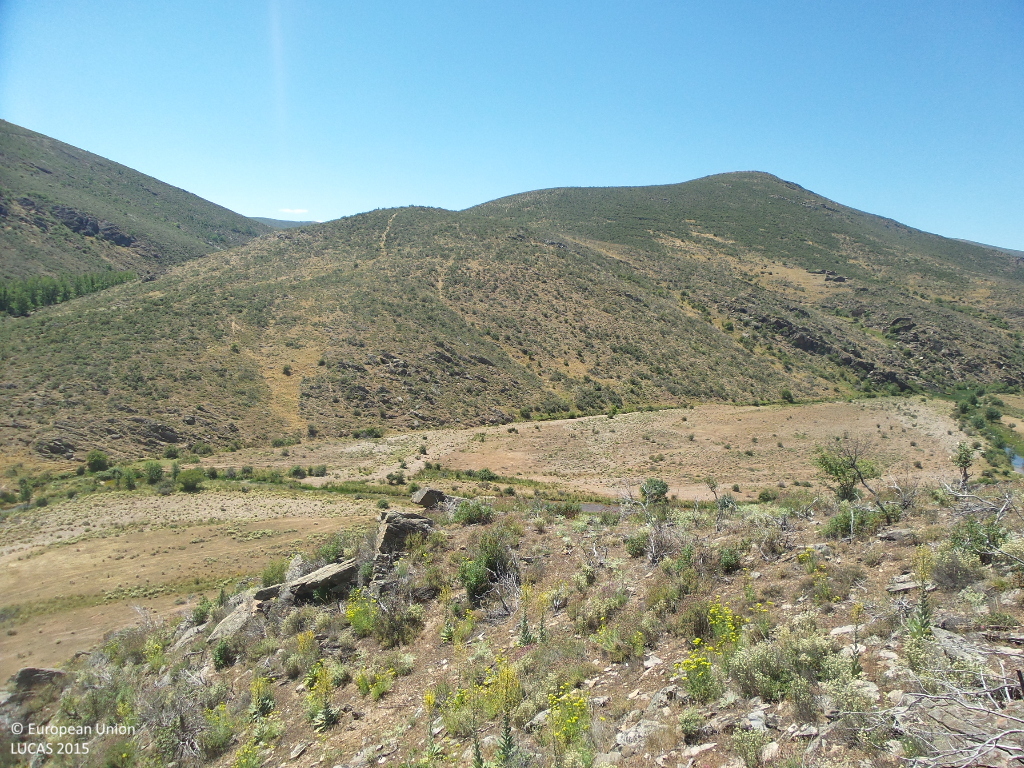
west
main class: Shrubland
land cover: Shrubland without tree cover
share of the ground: 10 - 25 %
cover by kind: consolidated bare surface 50 %, unconsolidated bare surface 30 %, shrubs 20 %
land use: Semi-natural and natural areas not in use
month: June
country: ES
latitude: 41.1293
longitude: -2.9129
